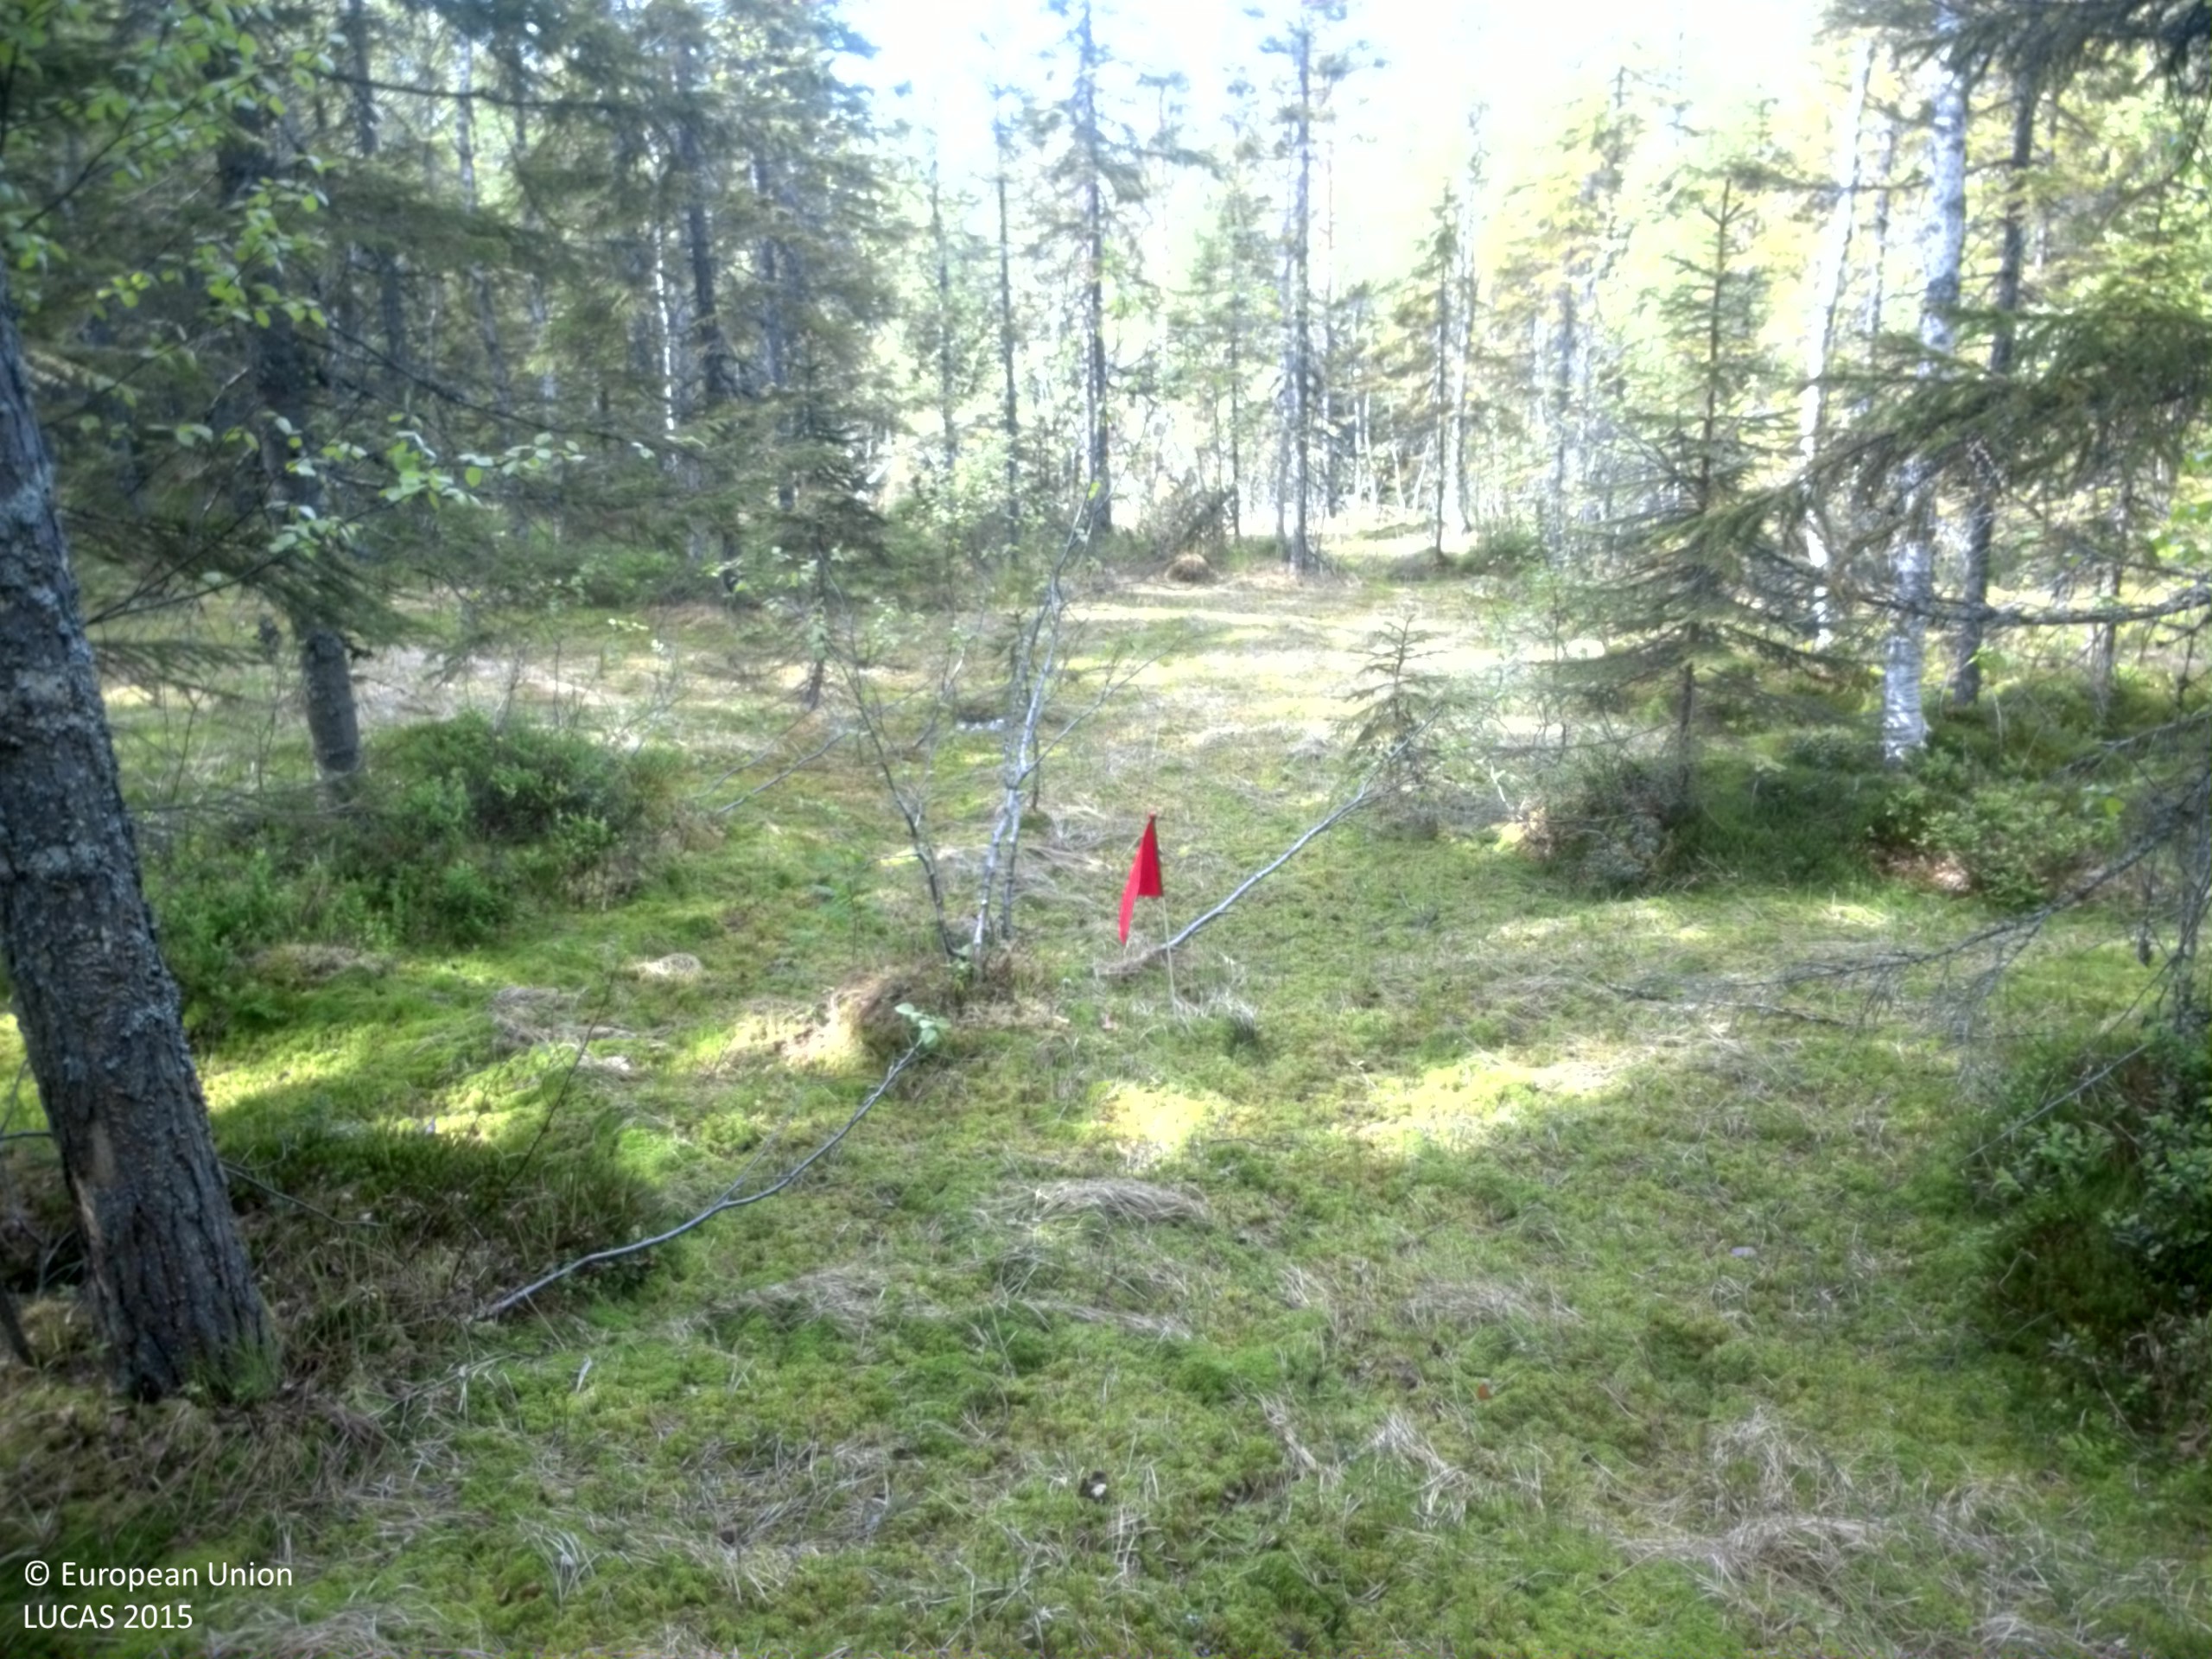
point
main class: Woodland
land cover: Spruce dominated mixed woodland
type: boreal forest
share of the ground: 50 - 75 %
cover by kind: coniferous forest trees 45 %, lichens and mosses 30 %, broadleaved forest trees 15 %, shrubs 10 %
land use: Forestry
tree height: > 5 m
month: June
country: SE
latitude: 62.9080
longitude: 17.9892
